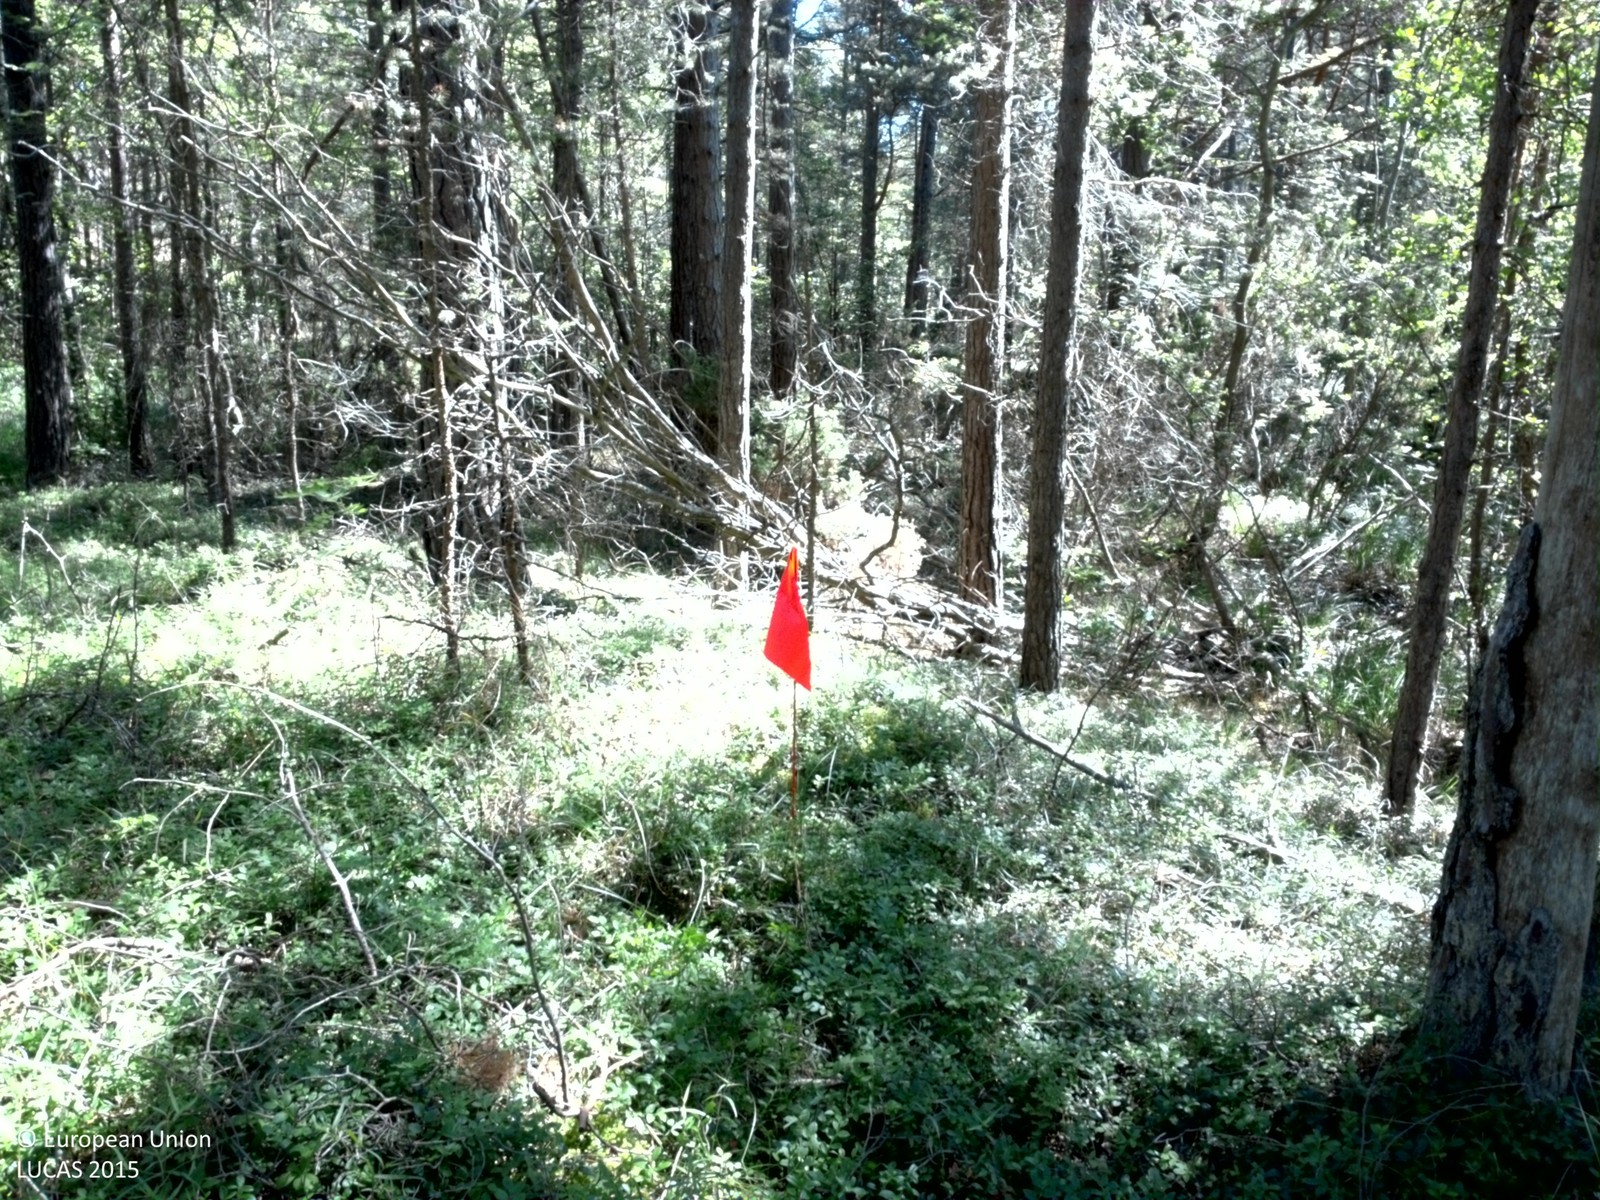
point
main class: Woodland
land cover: Pine dominated mixed woodland
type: hemiboreal forest and nemoral coniferous forest and mixed broadleaved-coniferous forest
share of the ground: > 75 %
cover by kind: coniferous forest trees 55 %, broadleaved forest trees 25 %, herbaceous plants 15 %, shrubs 5 %
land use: Forestry
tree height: > 5 m
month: July
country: SE
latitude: 57.9672
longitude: 19.3268
